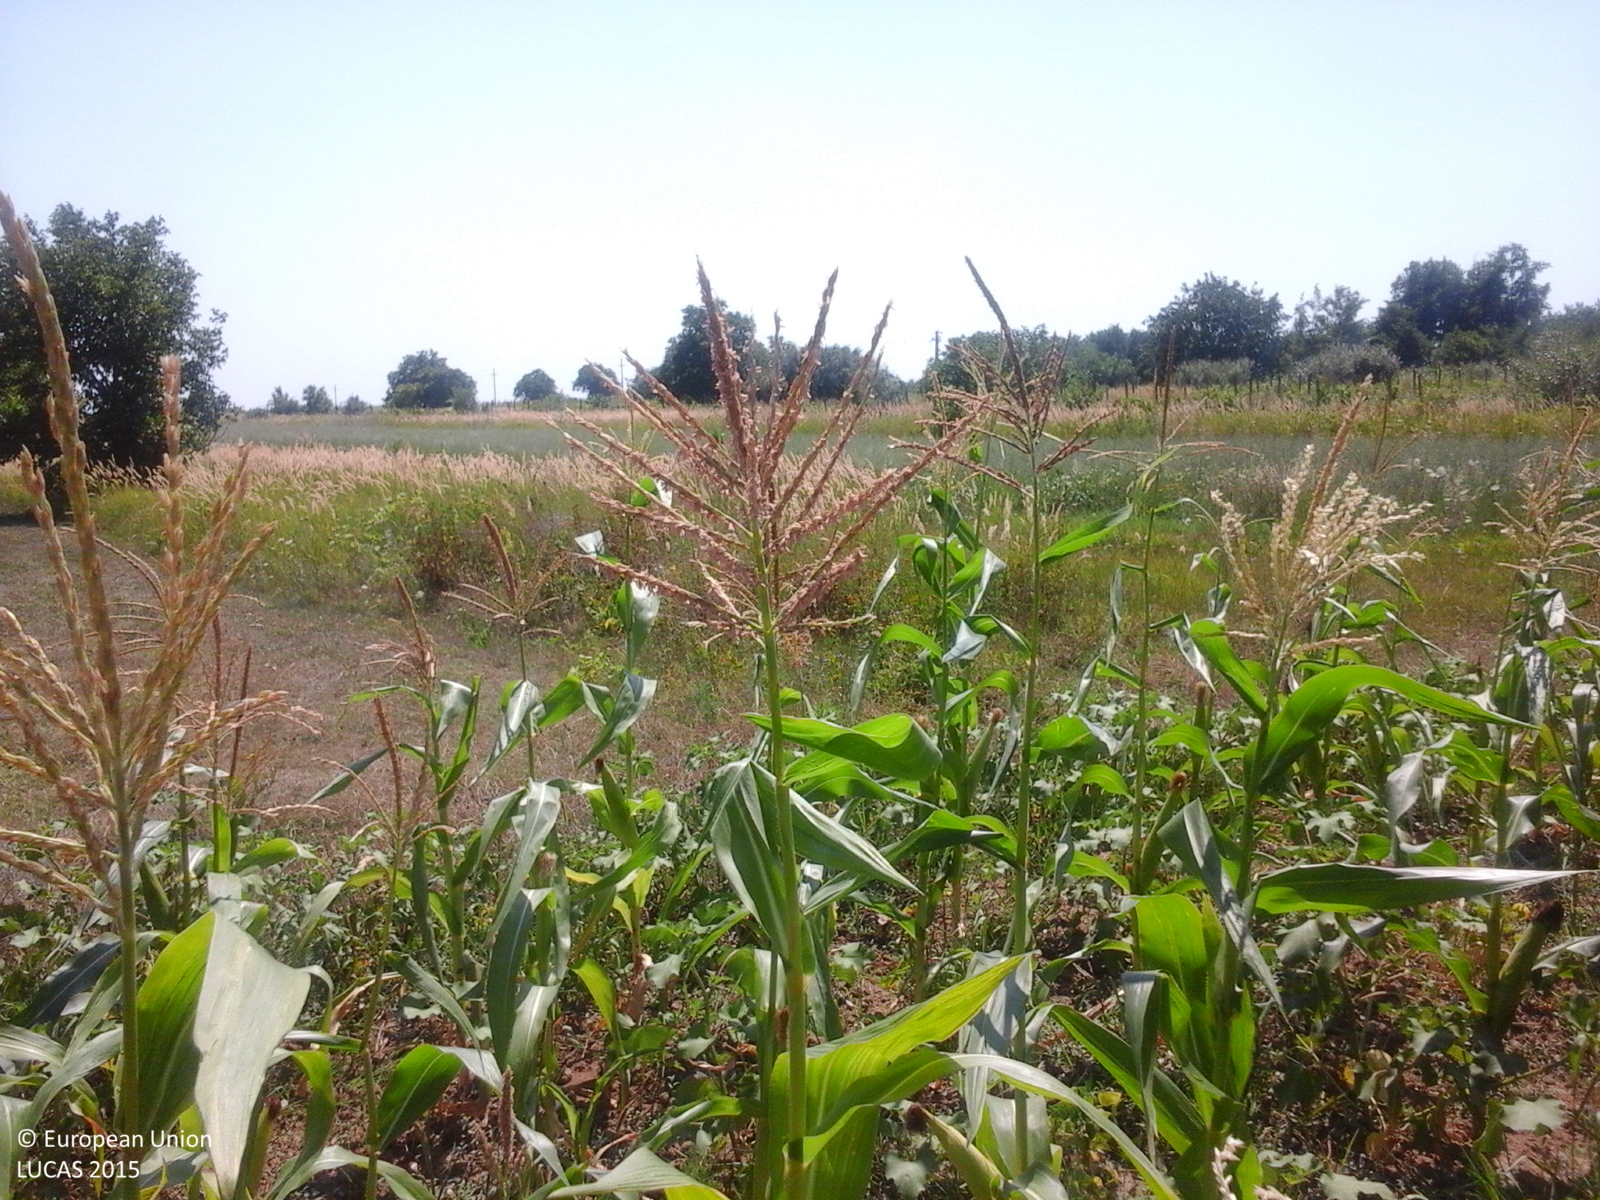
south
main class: Cropland
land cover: Maize
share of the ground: > 75 %
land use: Agriculture (excluding fallow land and kitchen gardens)
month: July
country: RO
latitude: 45.9975
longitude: 27.2859
